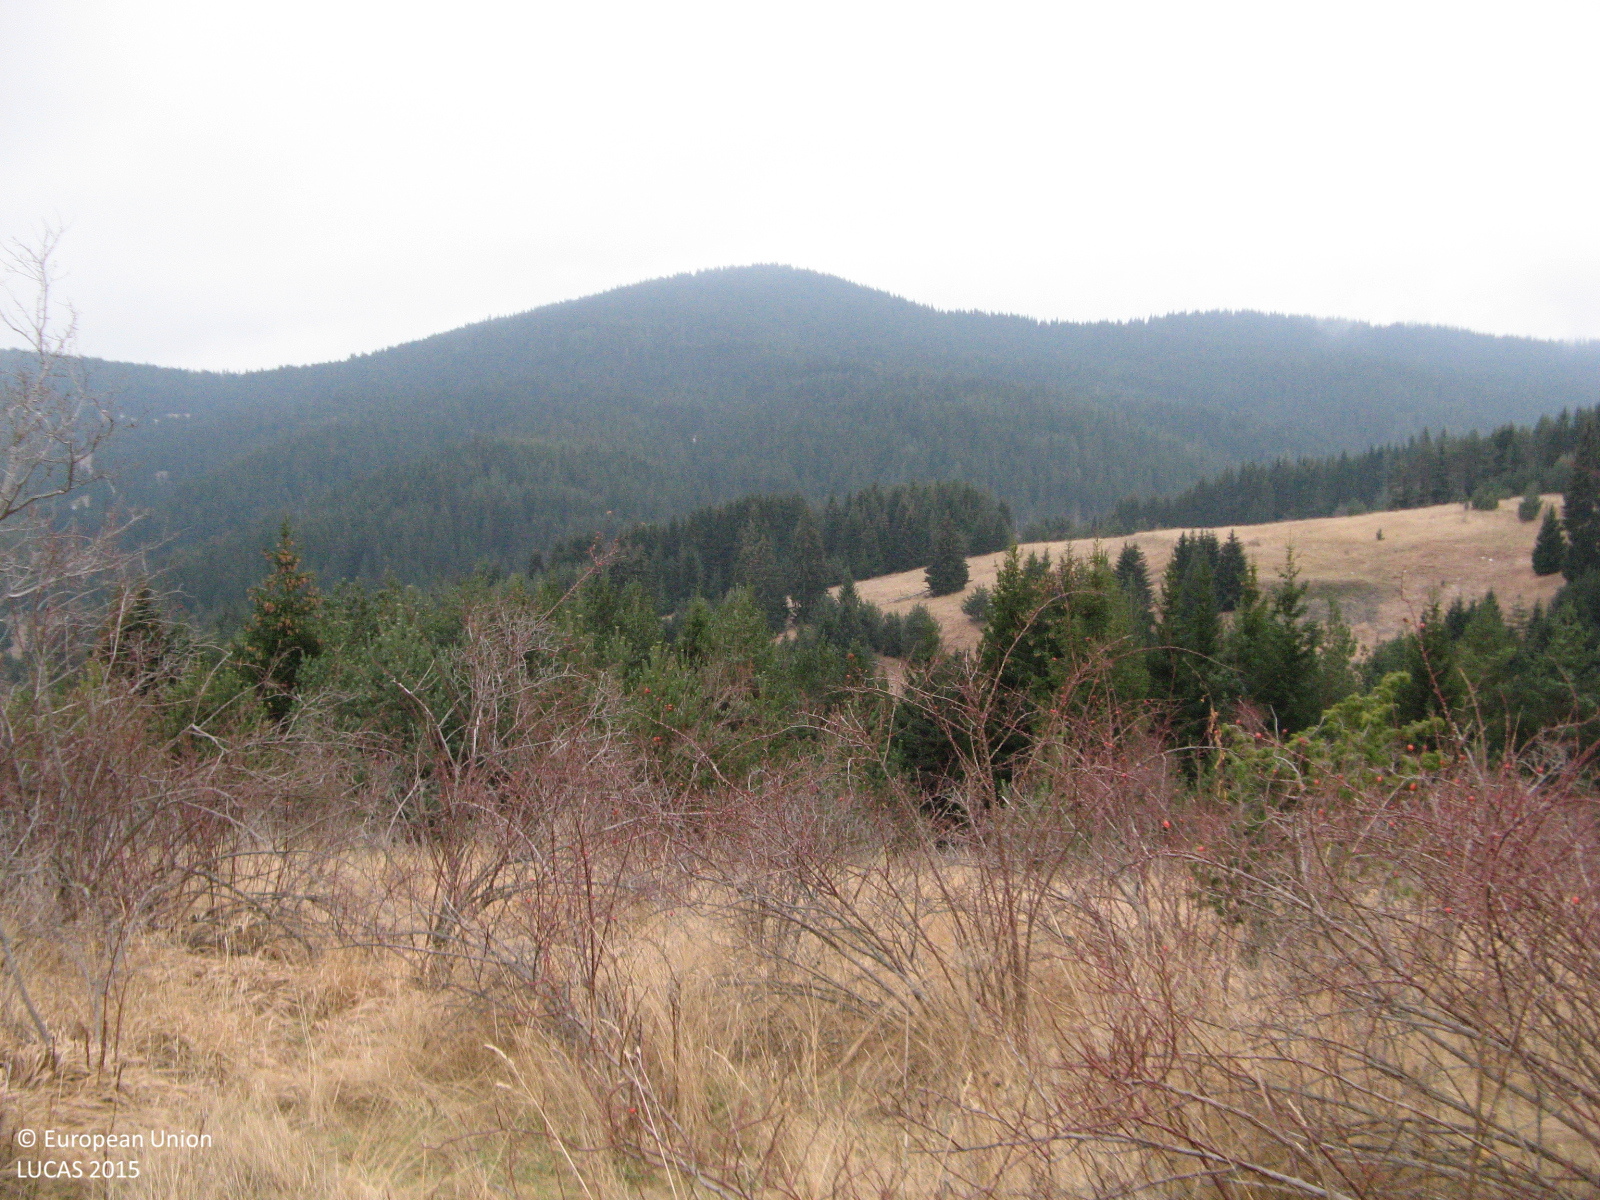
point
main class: Woodland
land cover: Spruce dominated coniferous woodland
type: alpine coniferous forest
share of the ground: > 75 %
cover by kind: coniferous forest trees 90 %, shrubs 5 %, herbaceous plants 5 %
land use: Forestry
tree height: > 5 m
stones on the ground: < 10 %
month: December
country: BG
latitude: 41.9053
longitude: 24.5717
